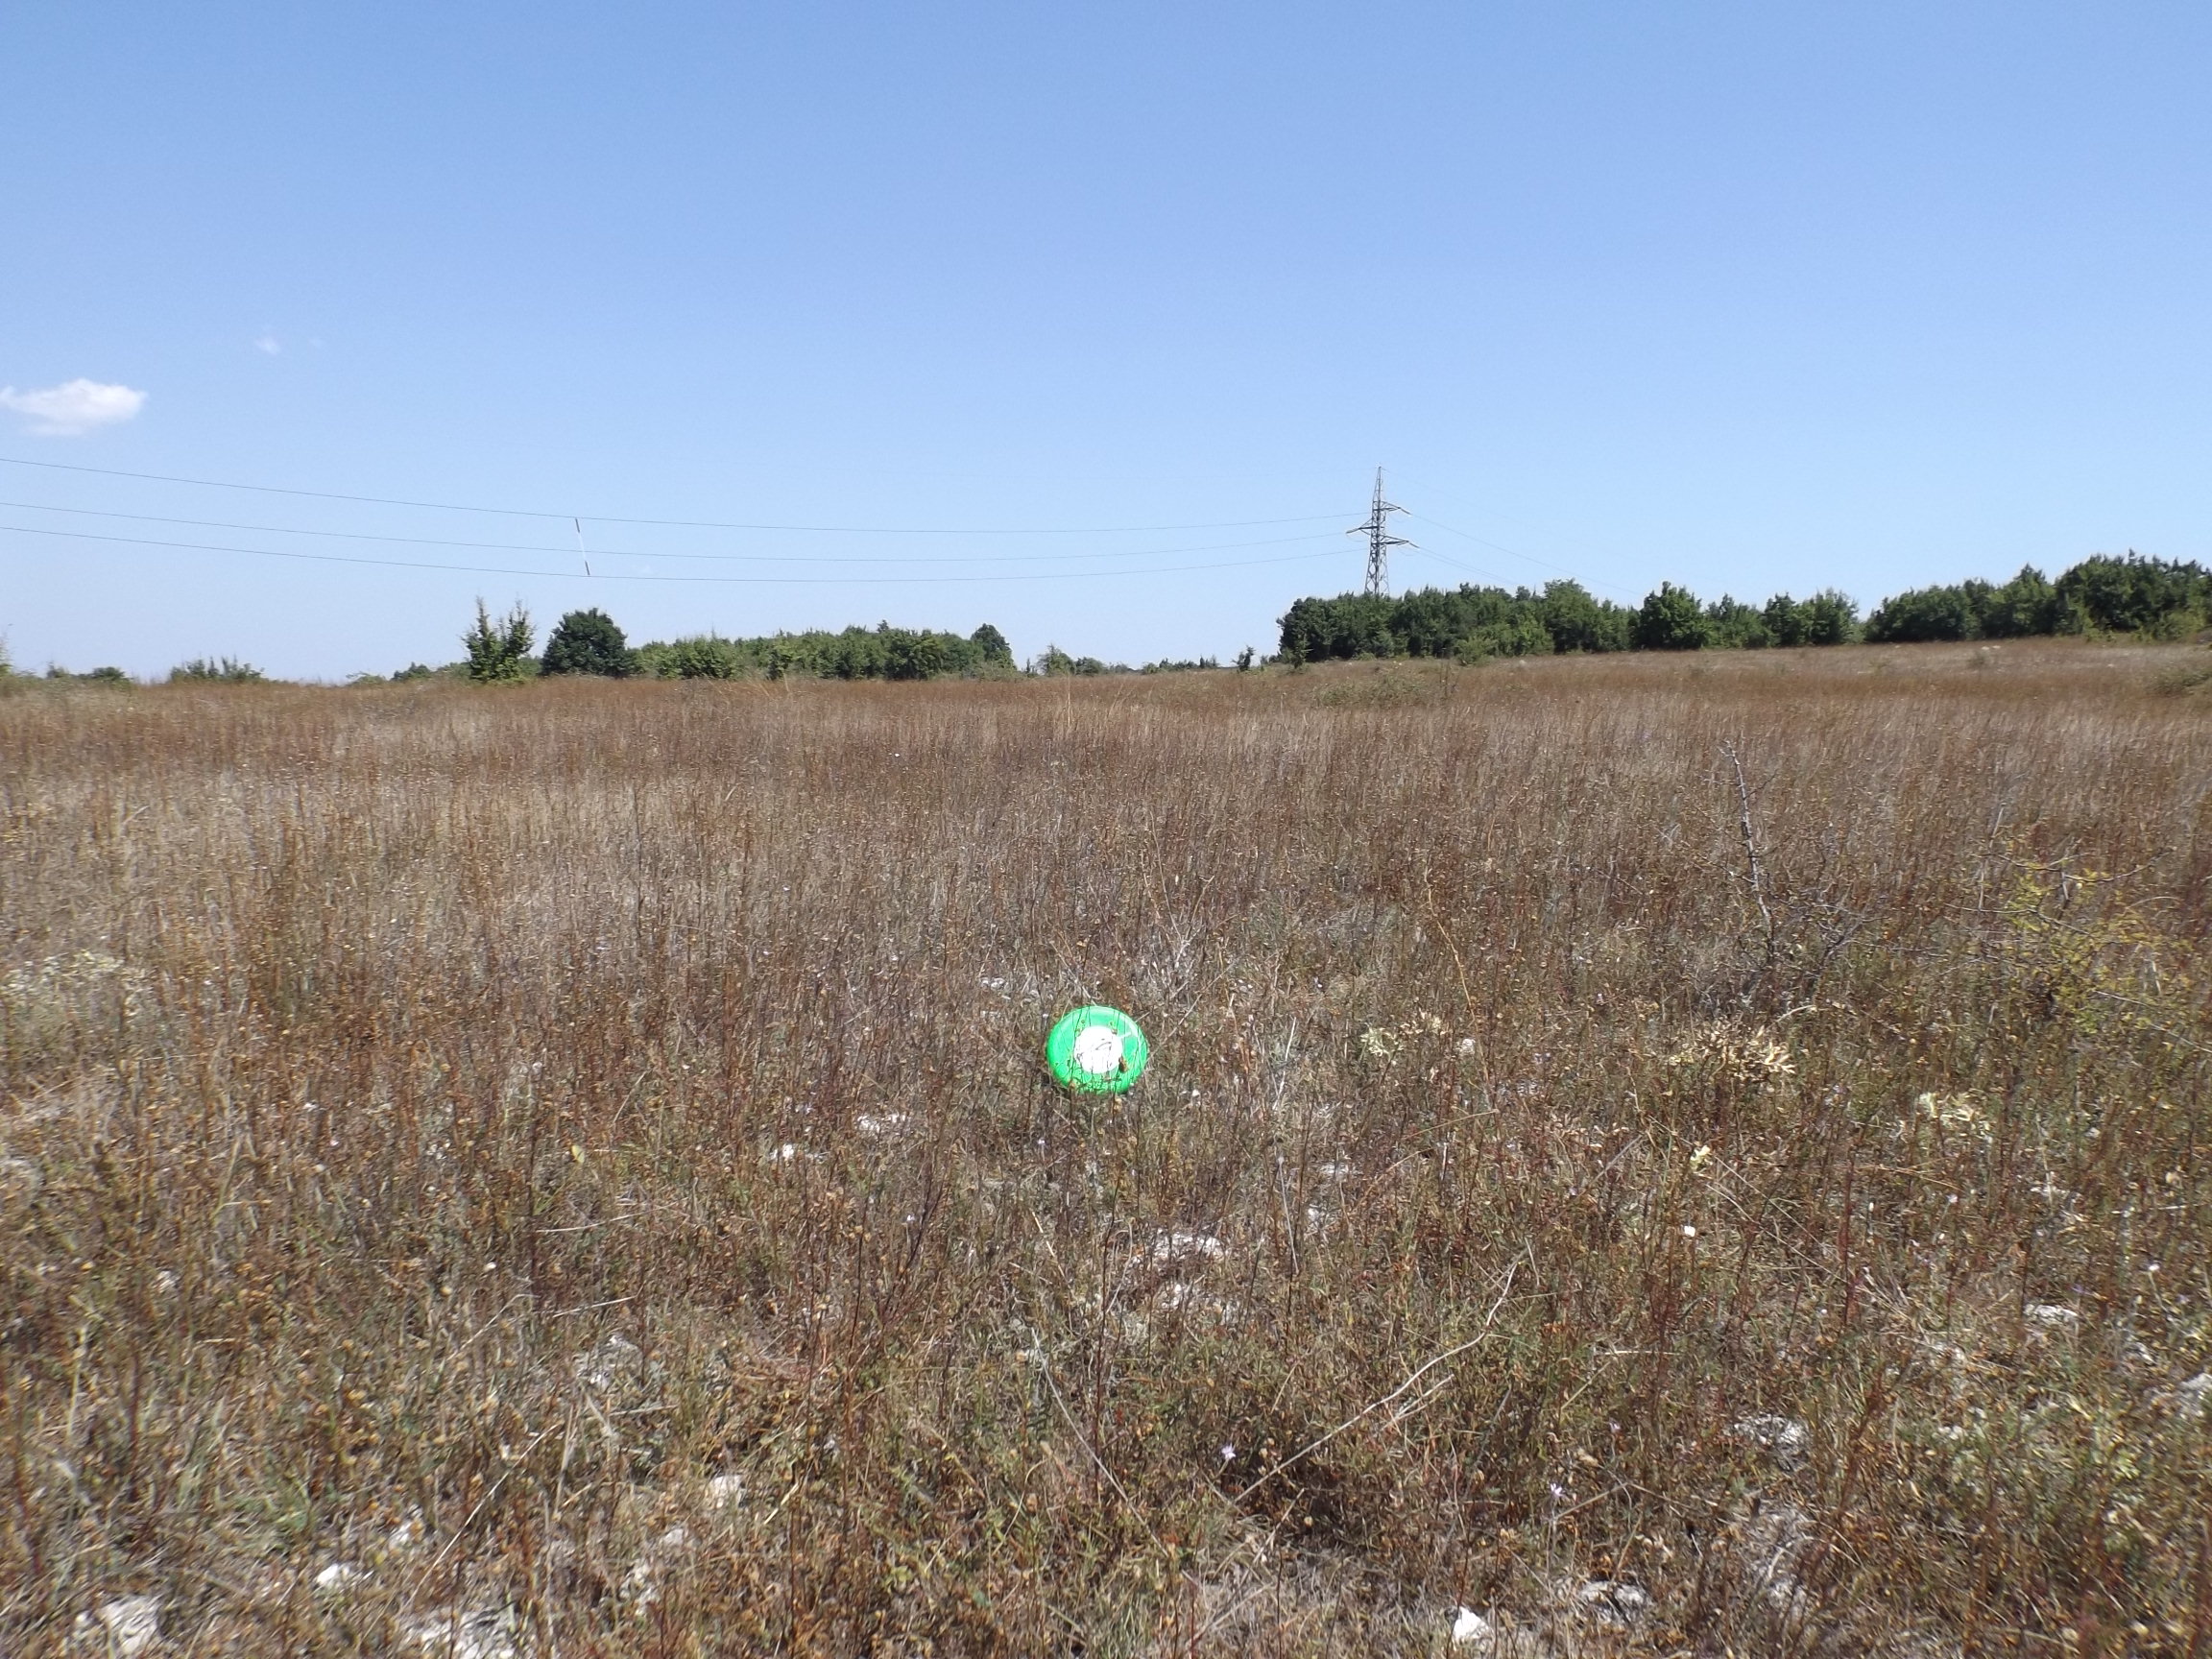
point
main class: Grassland
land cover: Grassland without tree/shrub cover
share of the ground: > 75 %
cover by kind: herbaceous plants 100 %
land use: Semi-natural and natural areas not in use
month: August
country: BG
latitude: 43.2600
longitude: 27.9921
